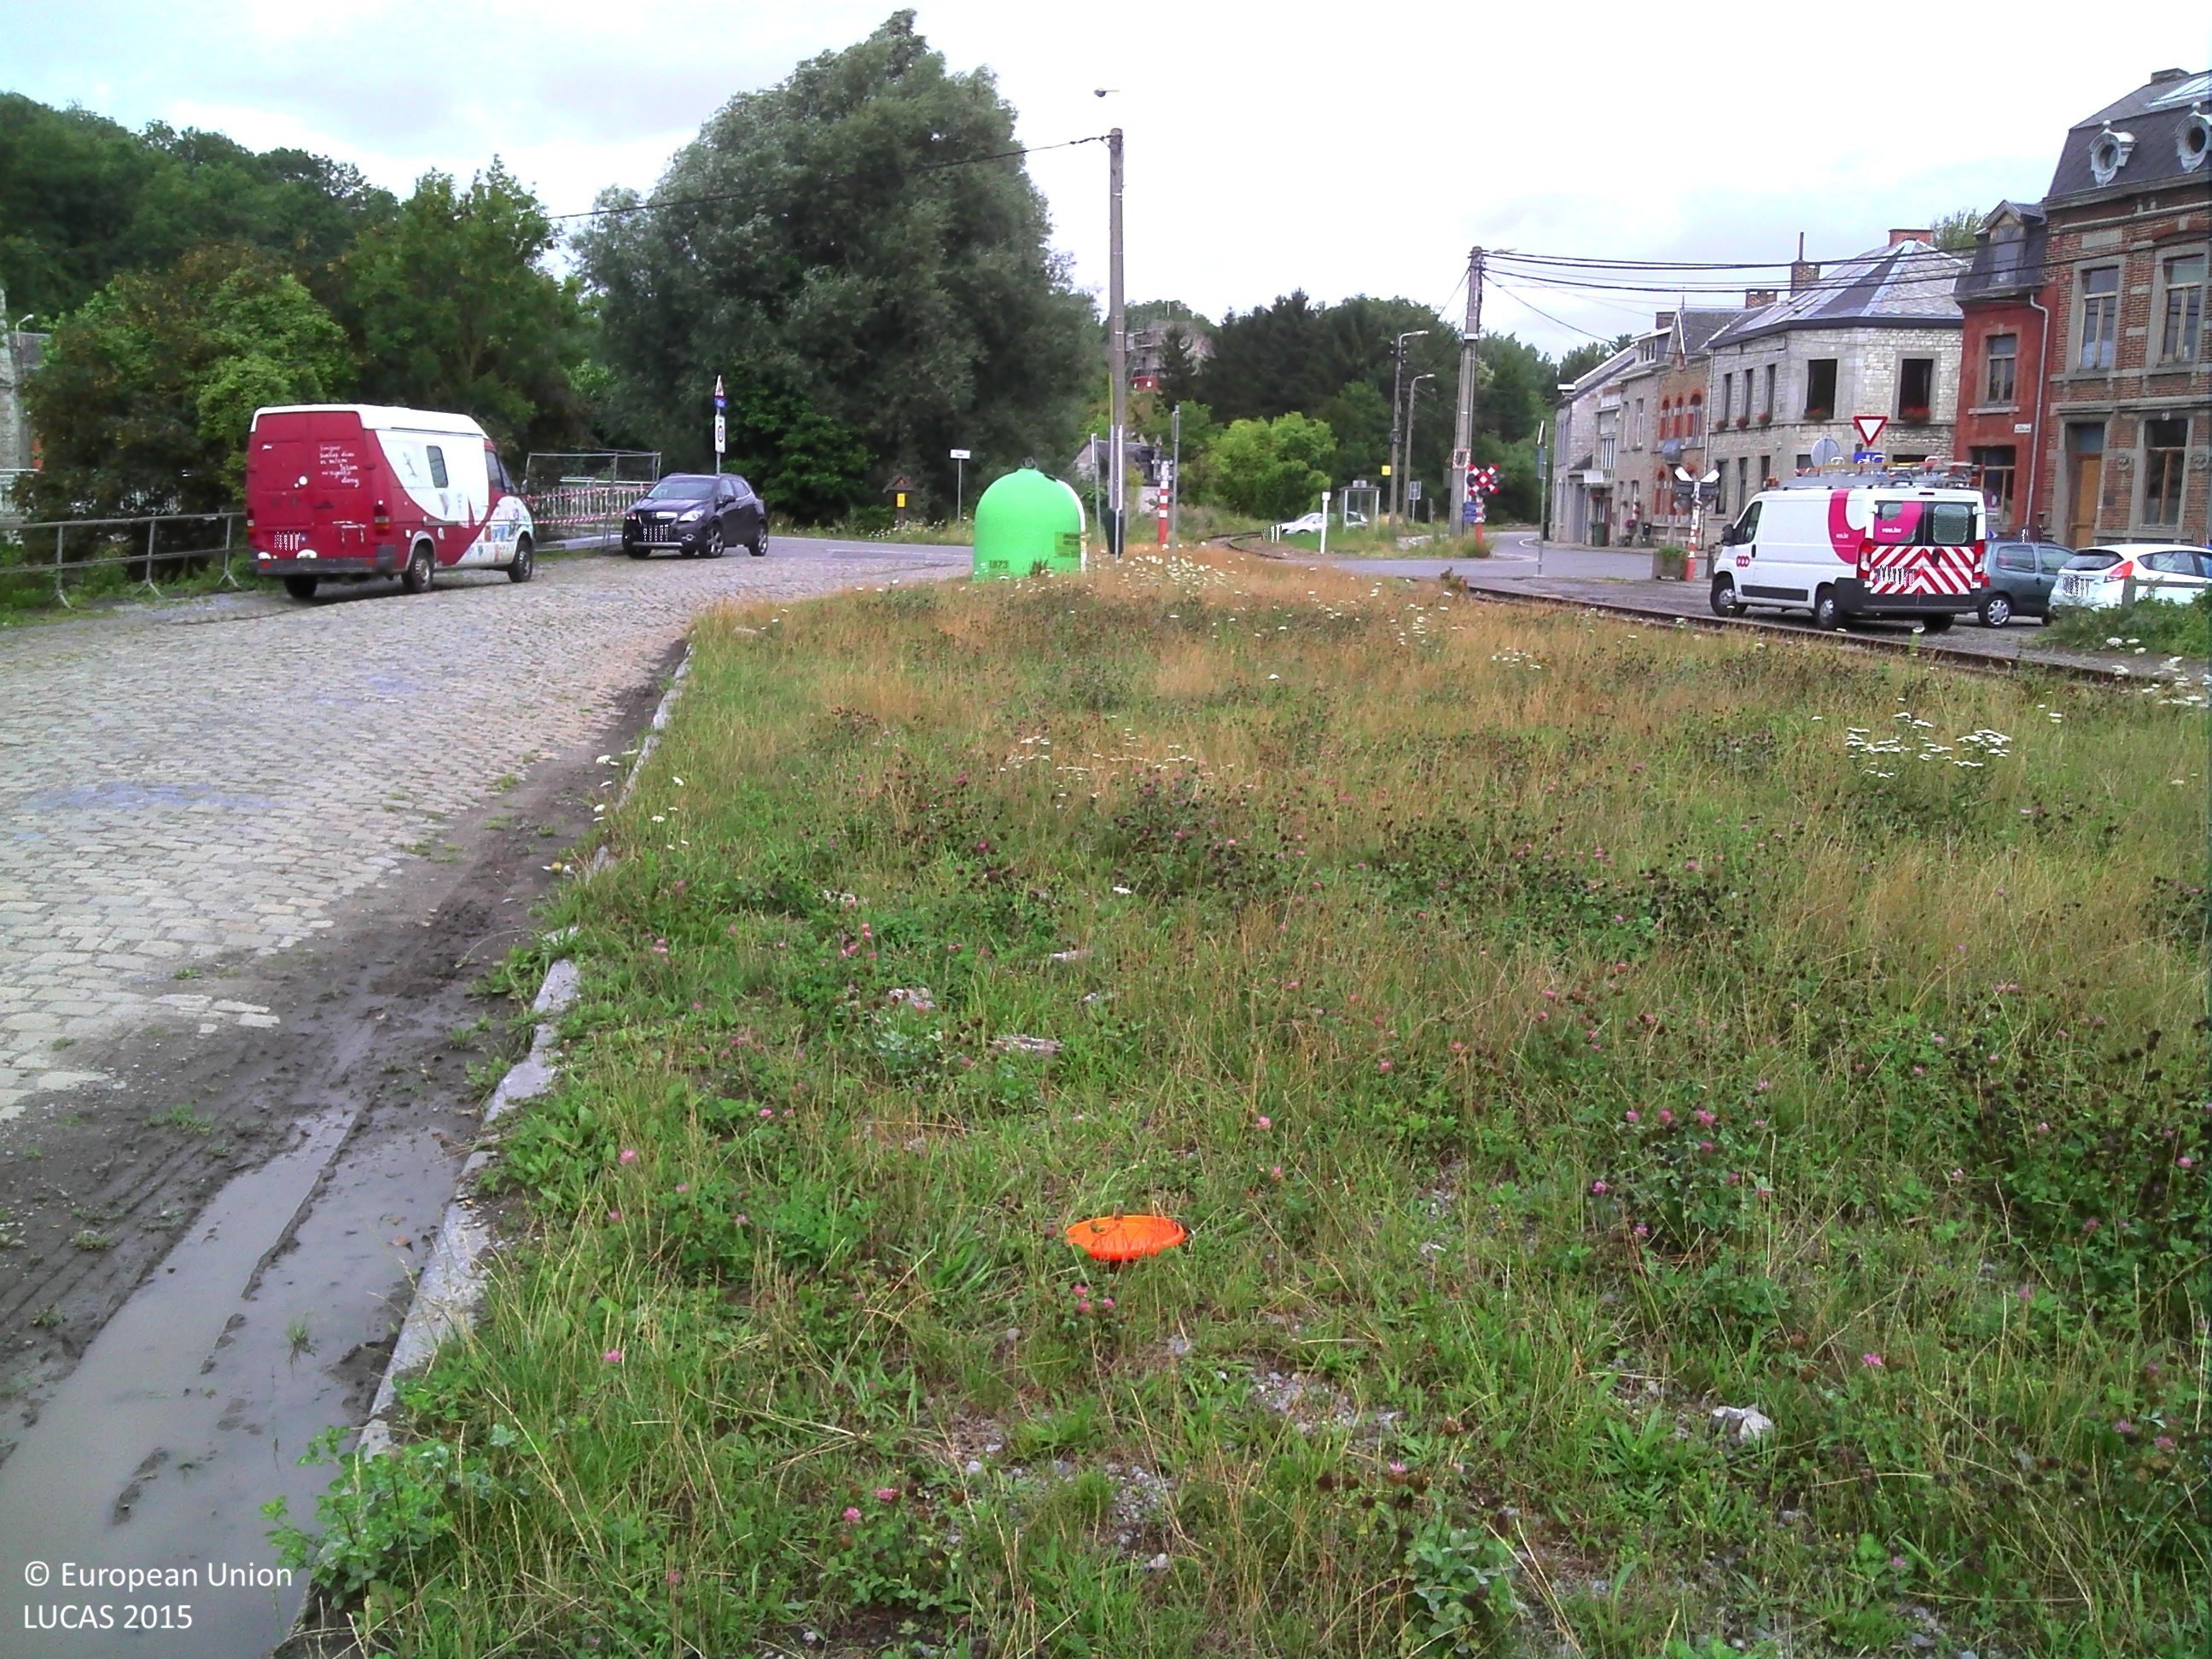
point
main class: Grassland
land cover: Grassland without tree/shrub cover
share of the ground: > 75 %
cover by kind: herbaceous plants 100 %
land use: Road transport
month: July
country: BE
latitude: 50.5509
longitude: 5.1848
